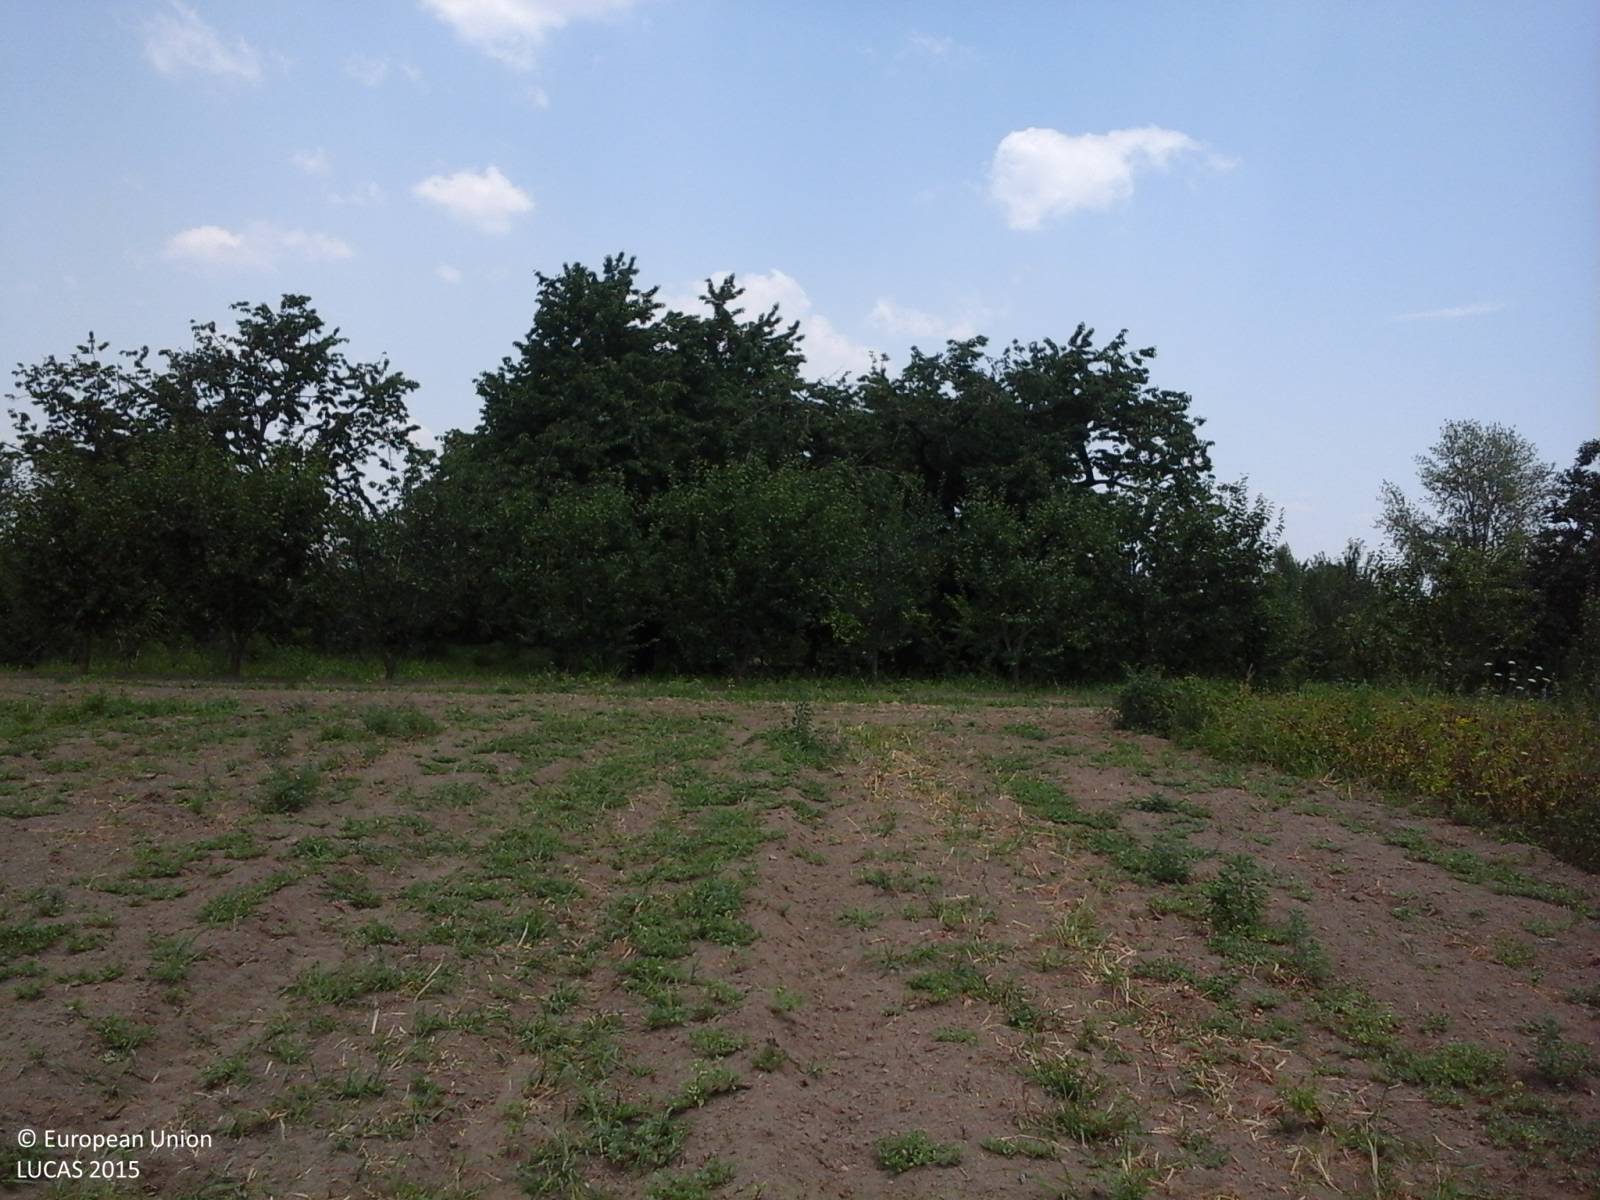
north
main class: Grassland
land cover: Spontaneously vegetated surfaces
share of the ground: < 10 %
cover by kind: herbaceous plants 100 %
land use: Agriculture (excluding fallow land and kitchen gardens)
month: July
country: IT
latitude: 40.9012
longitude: 14.2204
